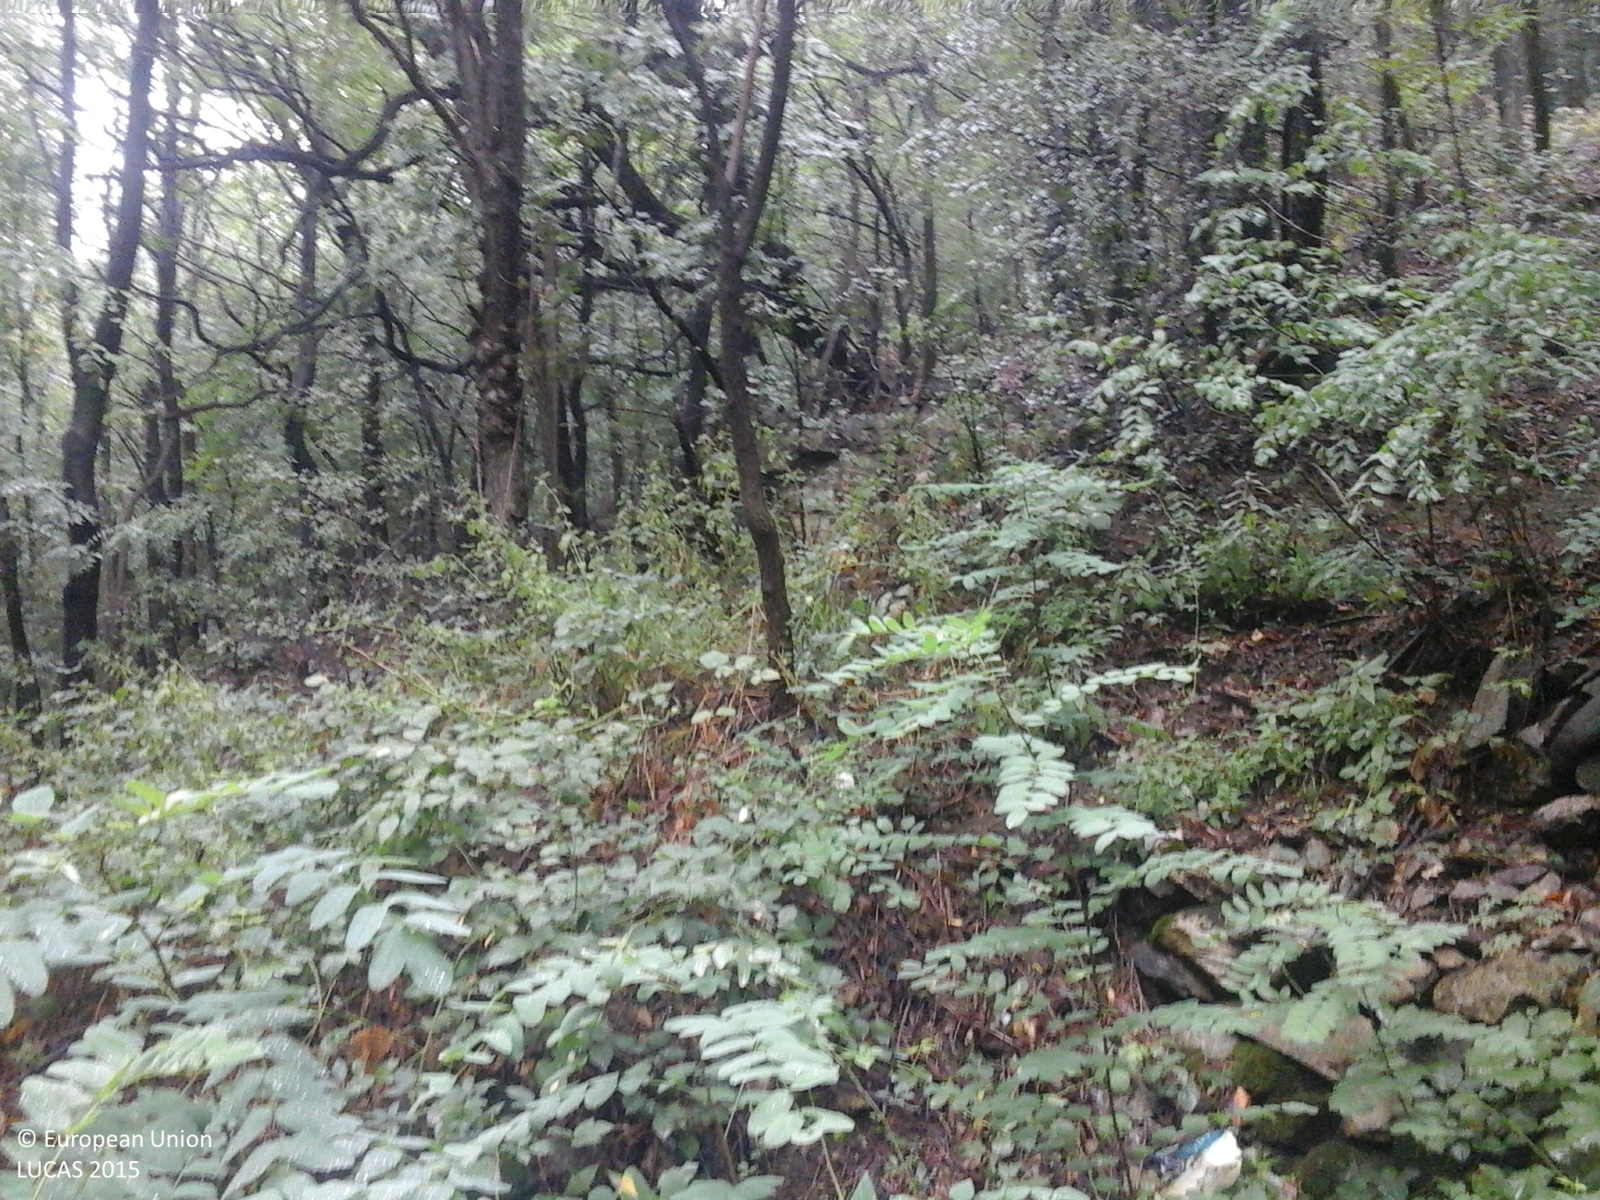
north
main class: Woodland
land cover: Broadleaved woodland
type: mesophytic deciduous forest
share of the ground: > 75 %
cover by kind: broadleaved forest trees 100 %
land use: Forestry
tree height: > 5 m
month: September
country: RO
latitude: 45.1953
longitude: 23.3843
